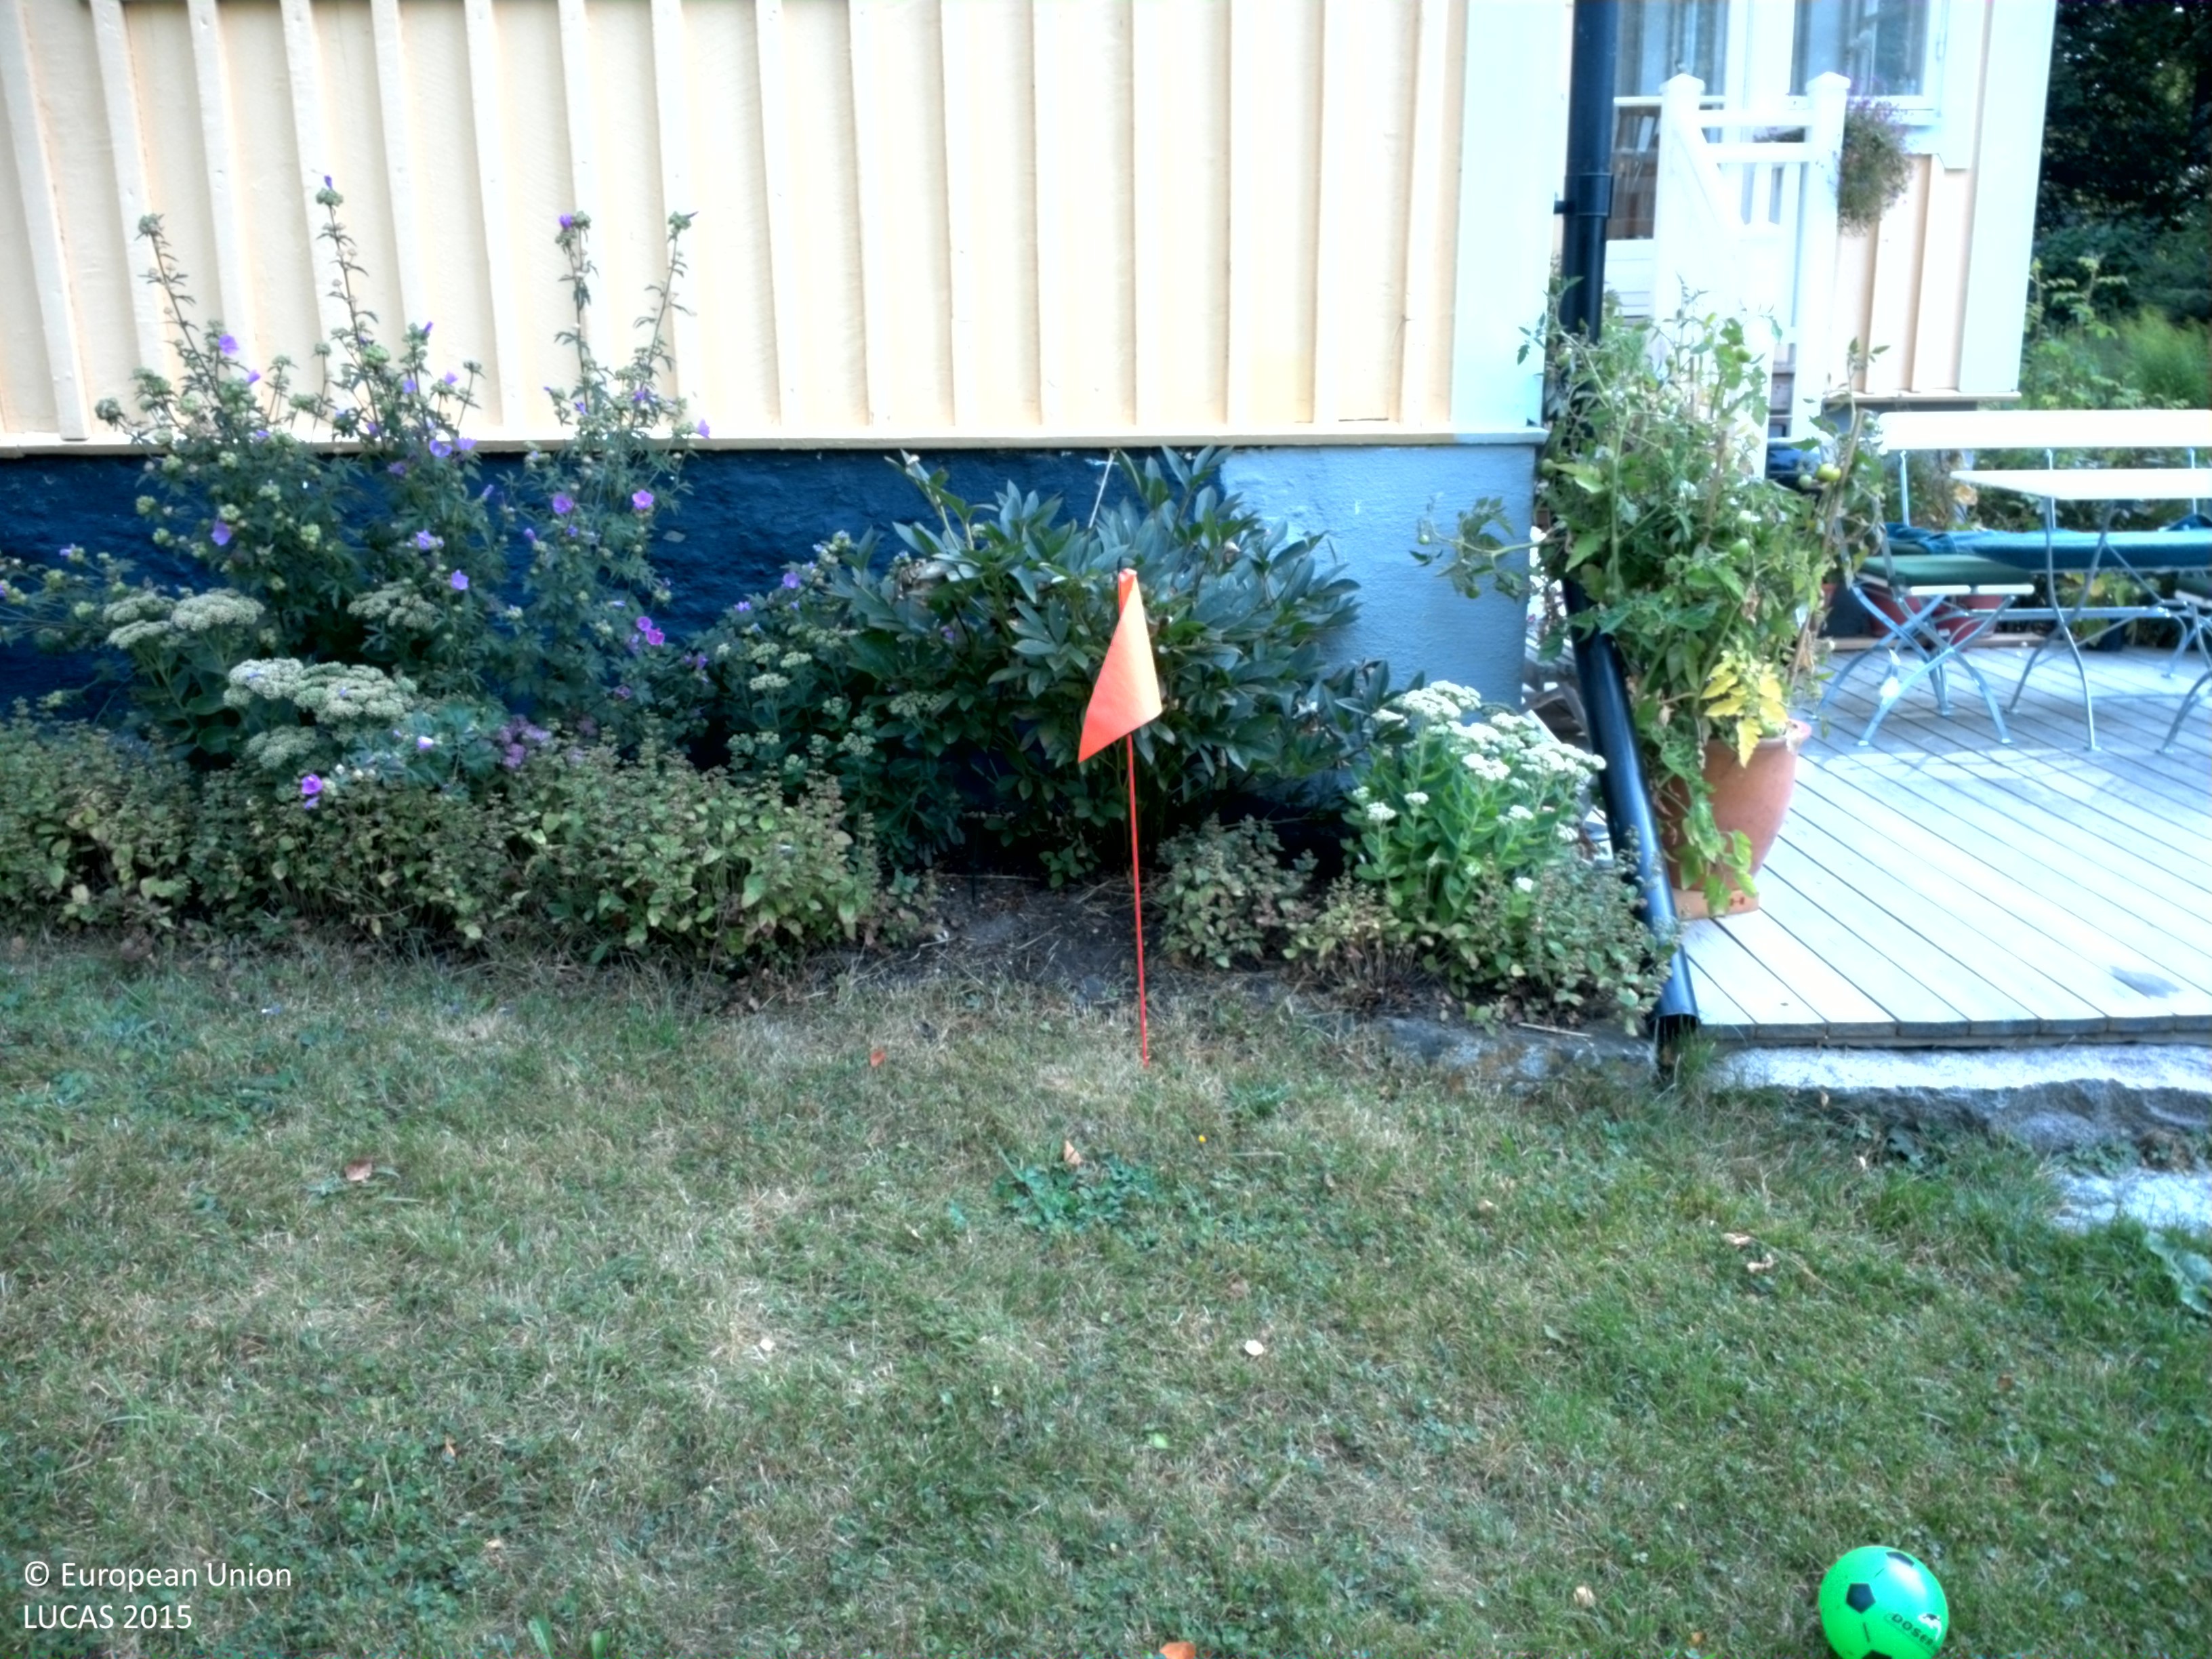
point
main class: Grassland
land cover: Grassland with sparse tree/shrub cover
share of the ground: > 75 %
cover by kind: herbaceous plants 95 %, broadleaved forest trees 5 %
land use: Residential
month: August
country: SE
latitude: 59.8661
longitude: 17.9424
